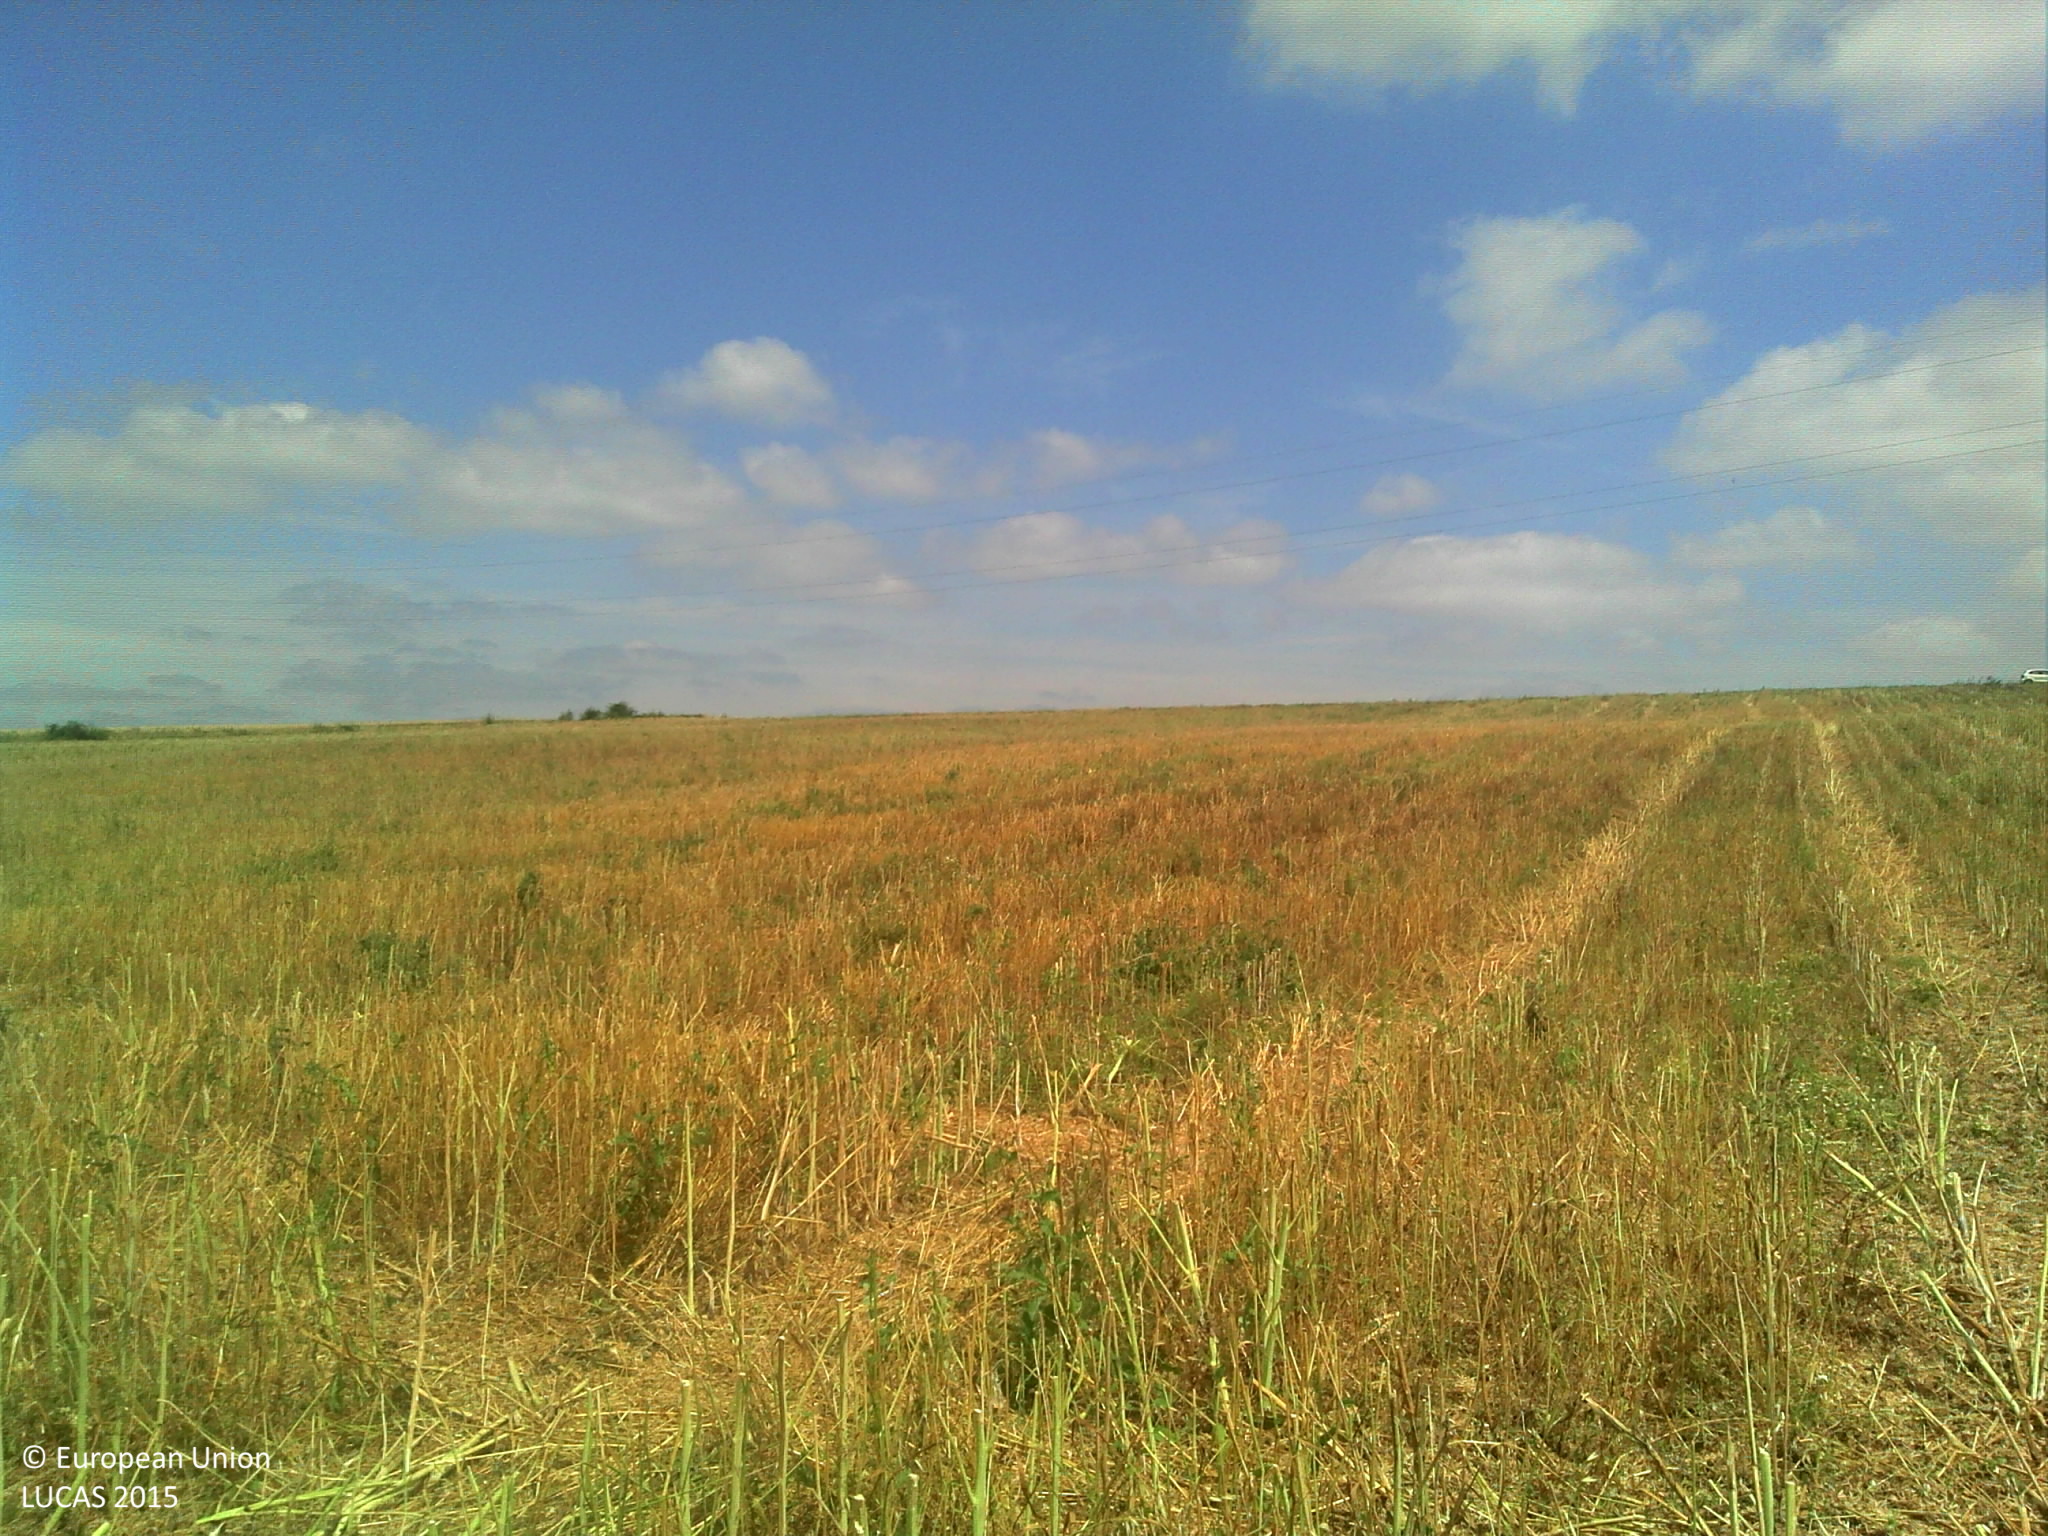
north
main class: Cropland
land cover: Rape and turnip rape
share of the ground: 25 - 50 %
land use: Agriculture (excluding fallow land and kitchen gardens)
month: June
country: FR
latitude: 44.1524
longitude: 0.9323
